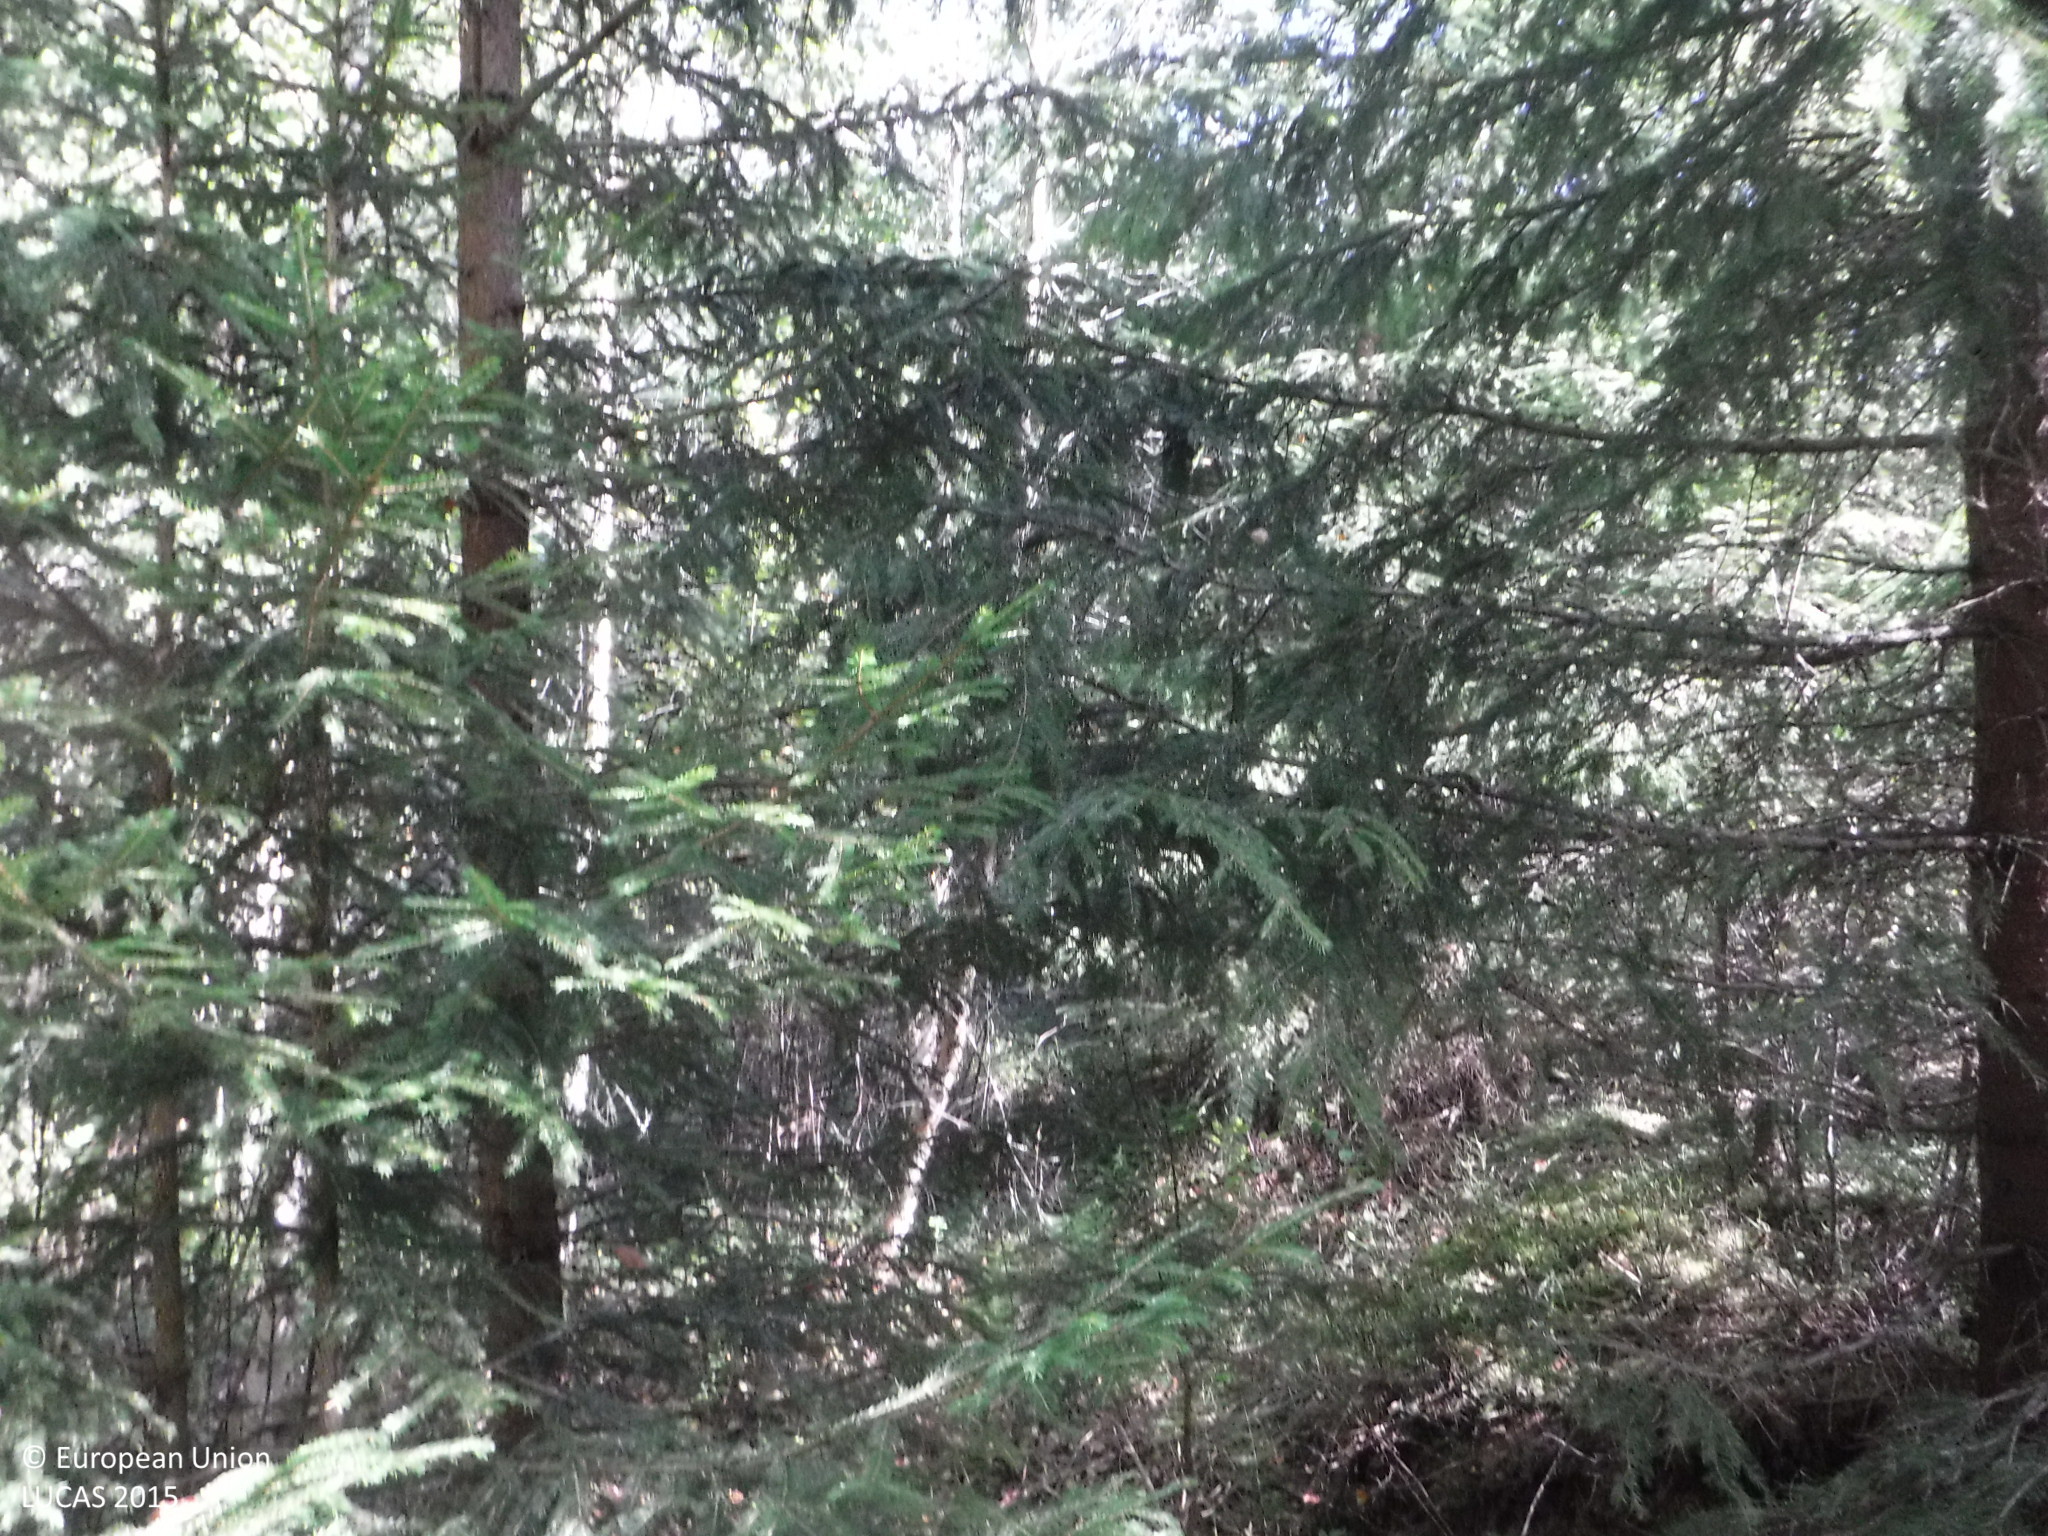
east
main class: Woodland
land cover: Spruce dominated mixed woodland
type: boreal forest
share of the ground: 50 - 75 %
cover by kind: coniferous forest trees 30 %, broadleaved forest trees 30 %, lichens and mosses 20 %, unconsolidated bare surface 10 %, shrubs 5 %, herbaceous plants 5 %
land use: Forestry
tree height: > 5 m
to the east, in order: Spruce dominated mixed woodland; Spruce dominated coniferous woodland; Ditches and canals; Shrubland without tree cover; Tracks; Spruce dominated coniferous woodland; Ditches and canals; Broadleaved woodland; Other coniferous woodland; Ditches and canals; Spruce dominated mixed woodland
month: August
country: FI
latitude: 61.1631
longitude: 22.8396
